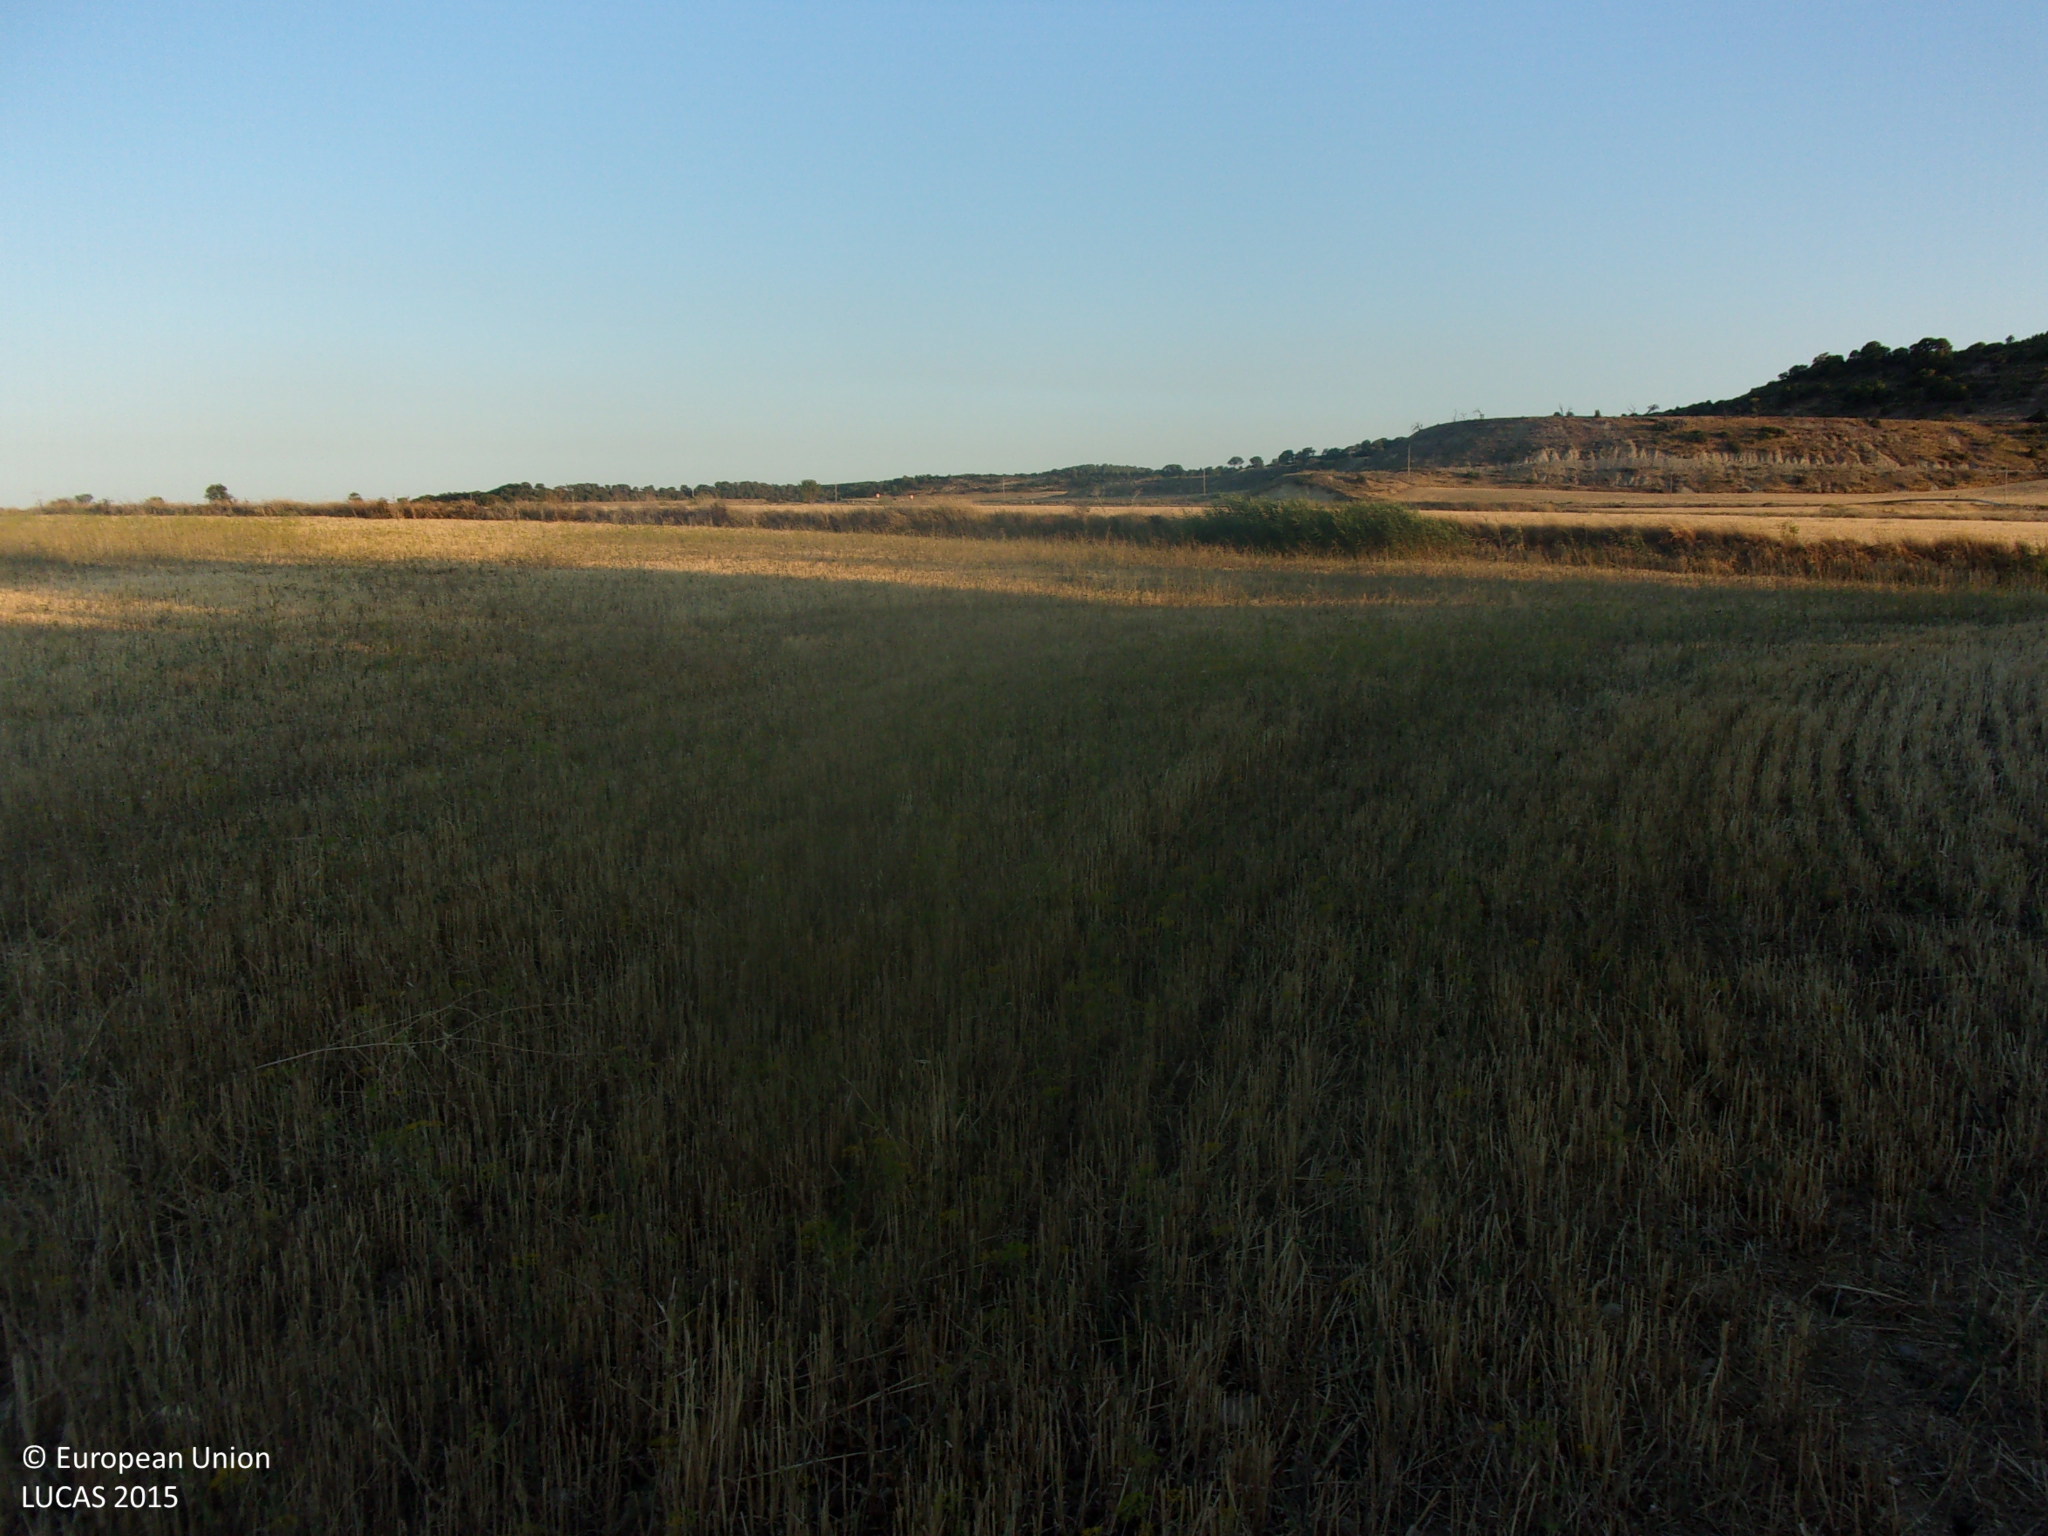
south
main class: Cropland
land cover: Barley
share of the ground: < 10 %
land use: Agriculture (excluding fallow land and kitchen gardens)
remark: Harvested field
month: July
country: ES
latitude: 42.0320
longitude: -0.8597
